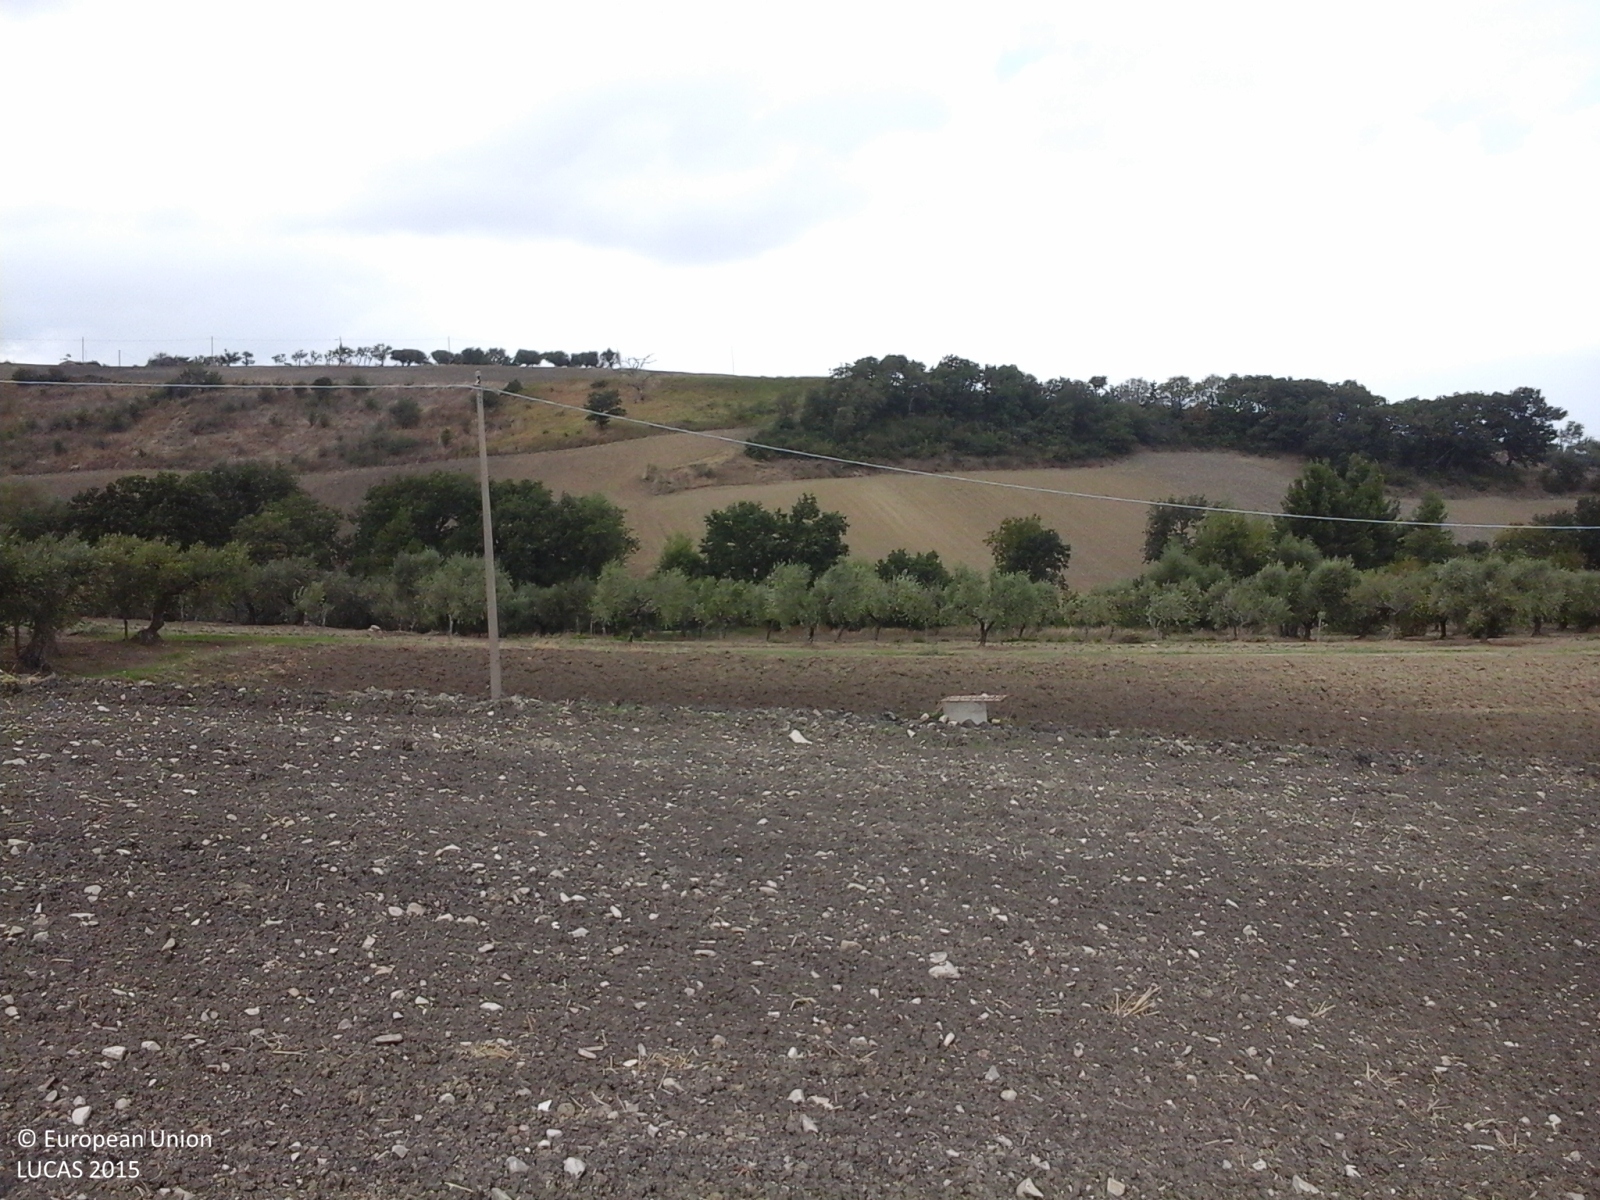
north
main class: Cropland
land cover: Durum wheat
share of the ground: > 75 %
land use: Agriculture (excluding fallow land and kitchen gardens)
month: October
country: IT
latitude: 41.4734
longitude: 15.1436
